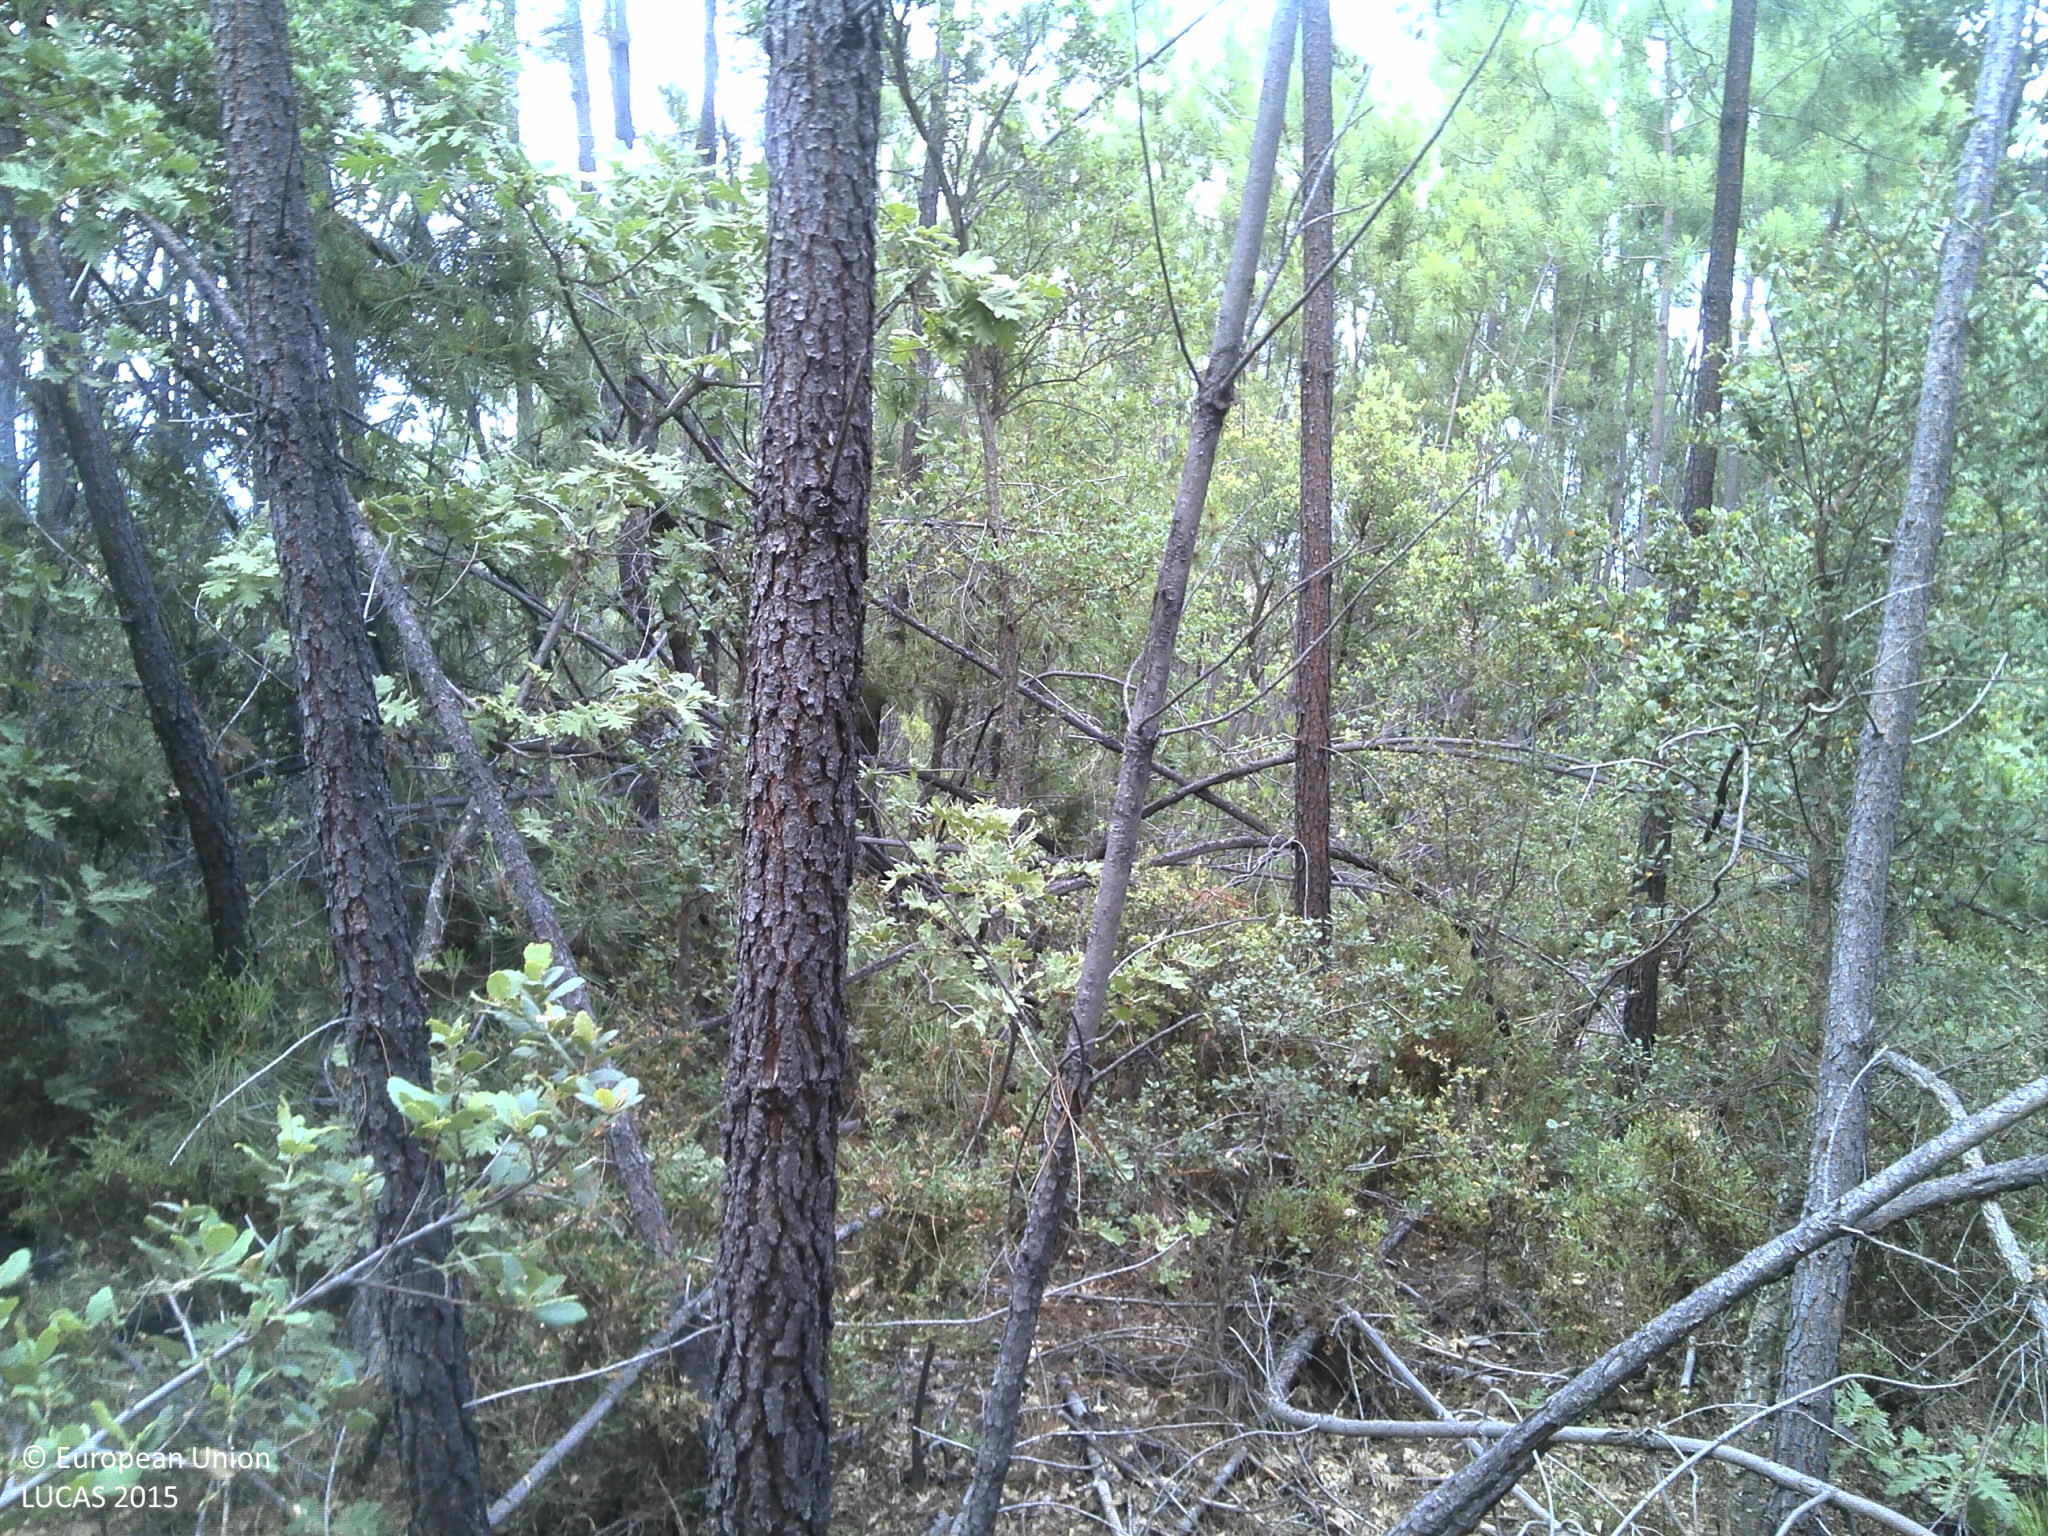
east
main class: Woodland
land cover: Pine dominated coniferous woodland
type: coniferous forest of the mediterranean region
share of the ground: 50 - 75 %
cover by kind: coniferous forest trees 55 %, shrubs 35 %, unconsolidated bare surface 10 %
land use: Forestry
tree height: > 5 m
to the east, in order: Pine dominated coniferous woodland; Shrubland with sparse tree cover
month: June
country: PT
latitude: 40.2484
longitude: -7.3008
